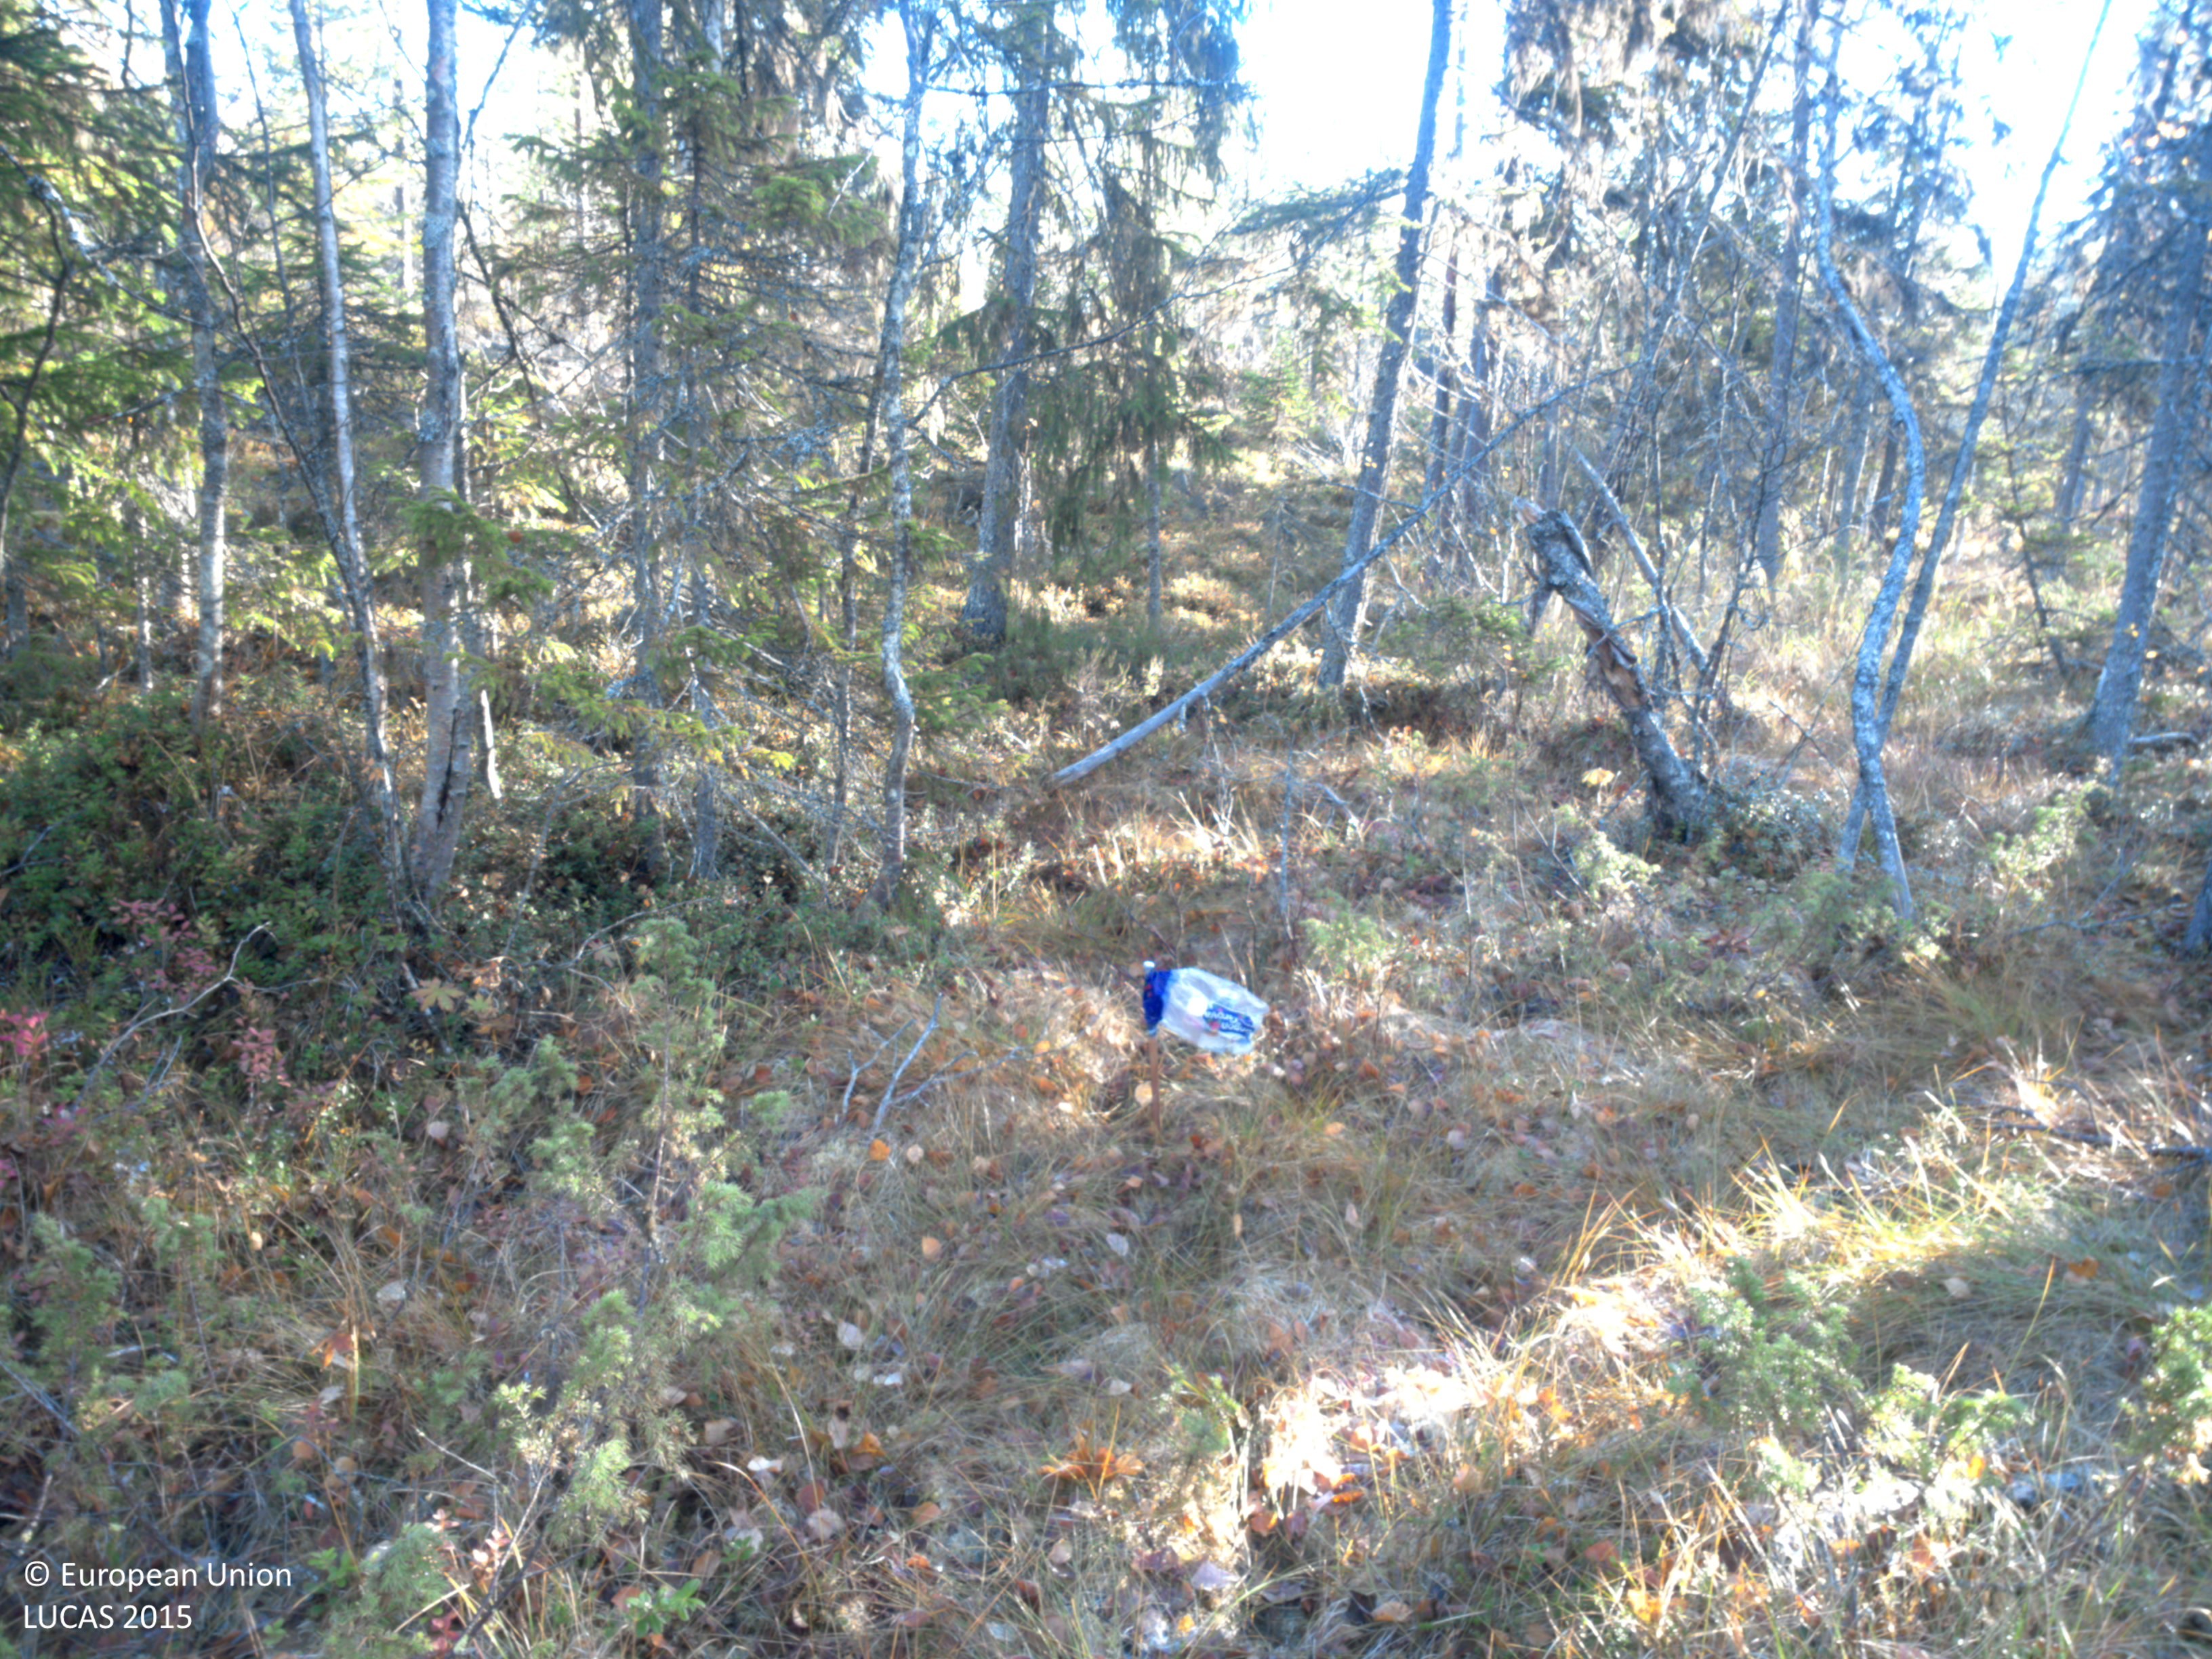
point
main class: Woodland
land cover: Spruce dominated mixed woodland
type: boreal forest
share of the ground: 50 - 75 %
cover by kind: coniferous forest trees 35 %, broadleaved forest trees 25 %, shrubs 20 %, herbaceous plants 10 %, lichens and mosses 10 %
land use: Forestry
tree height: > 5 m
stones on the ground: < 10 %
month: October
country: SE
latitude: 64.7353
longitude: 18.4711
